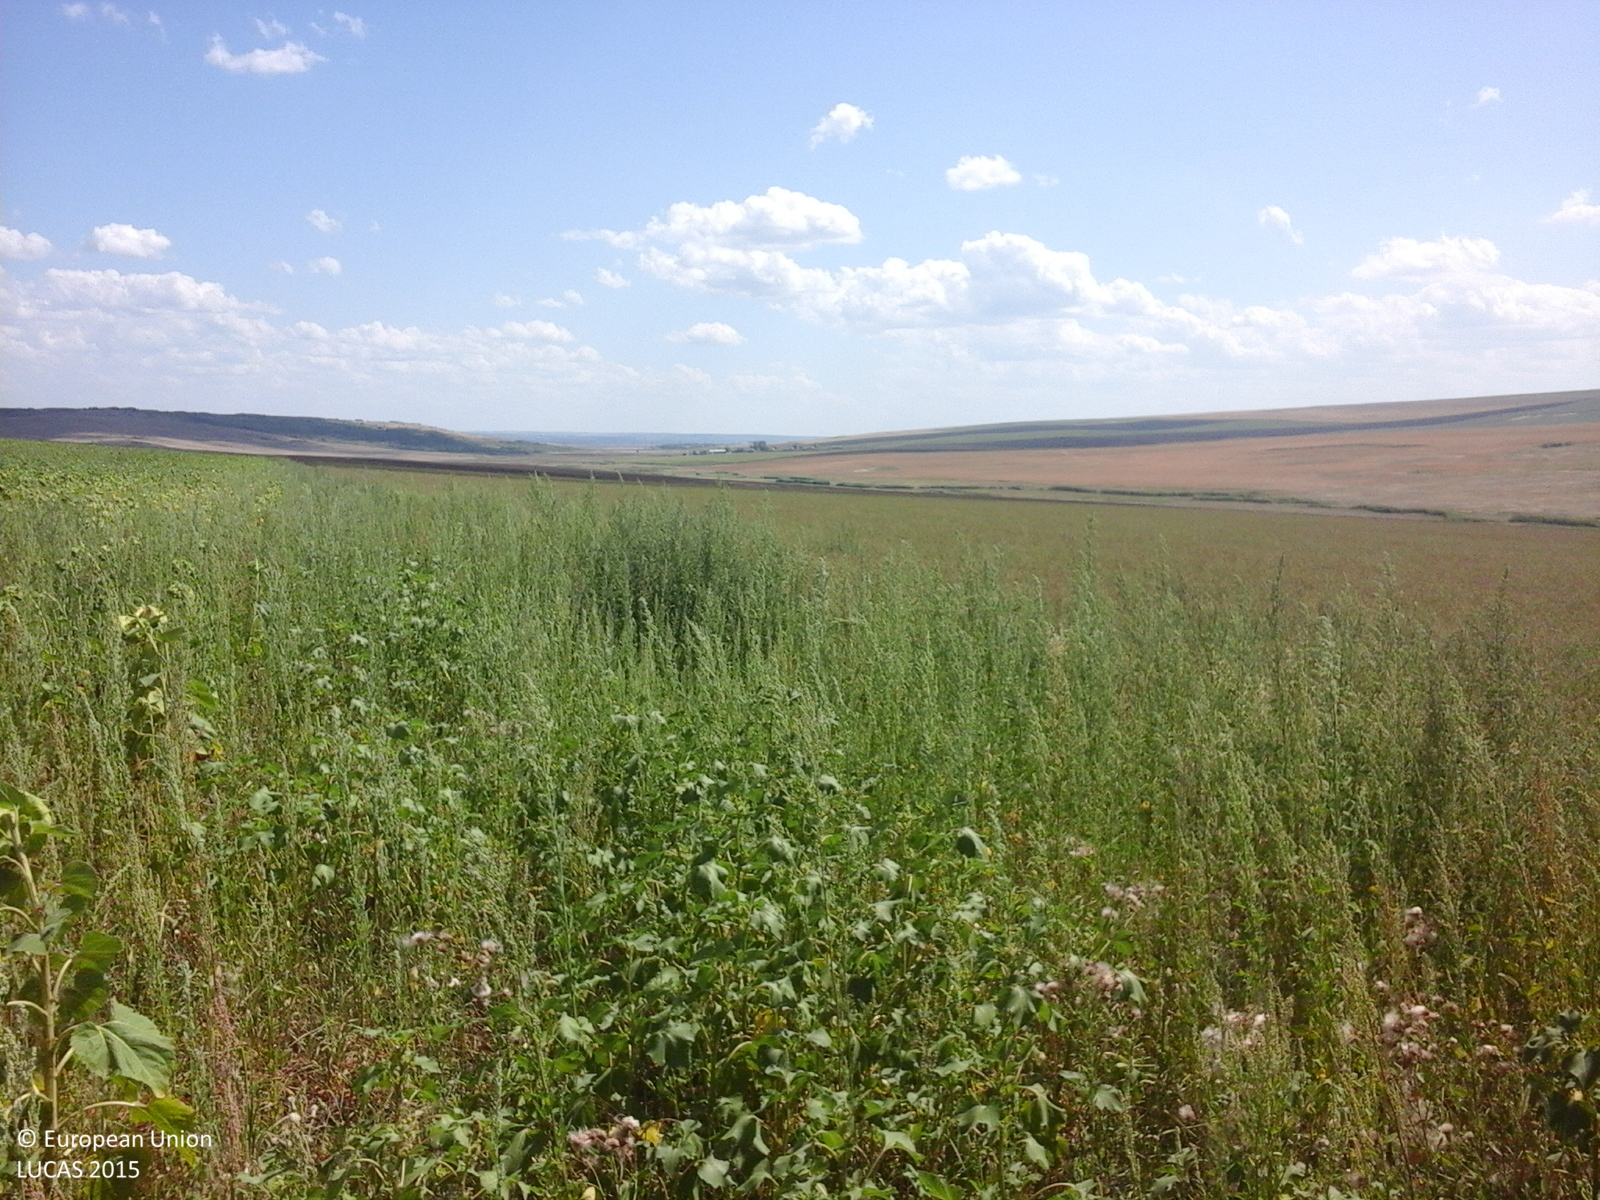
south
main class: Cropland
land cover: Sunflower
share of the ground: > 75 %
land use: Agriculture (excluding fallow land and kitchen gardens)
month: July
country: RO
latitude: 46.4618
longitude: 28.1389
